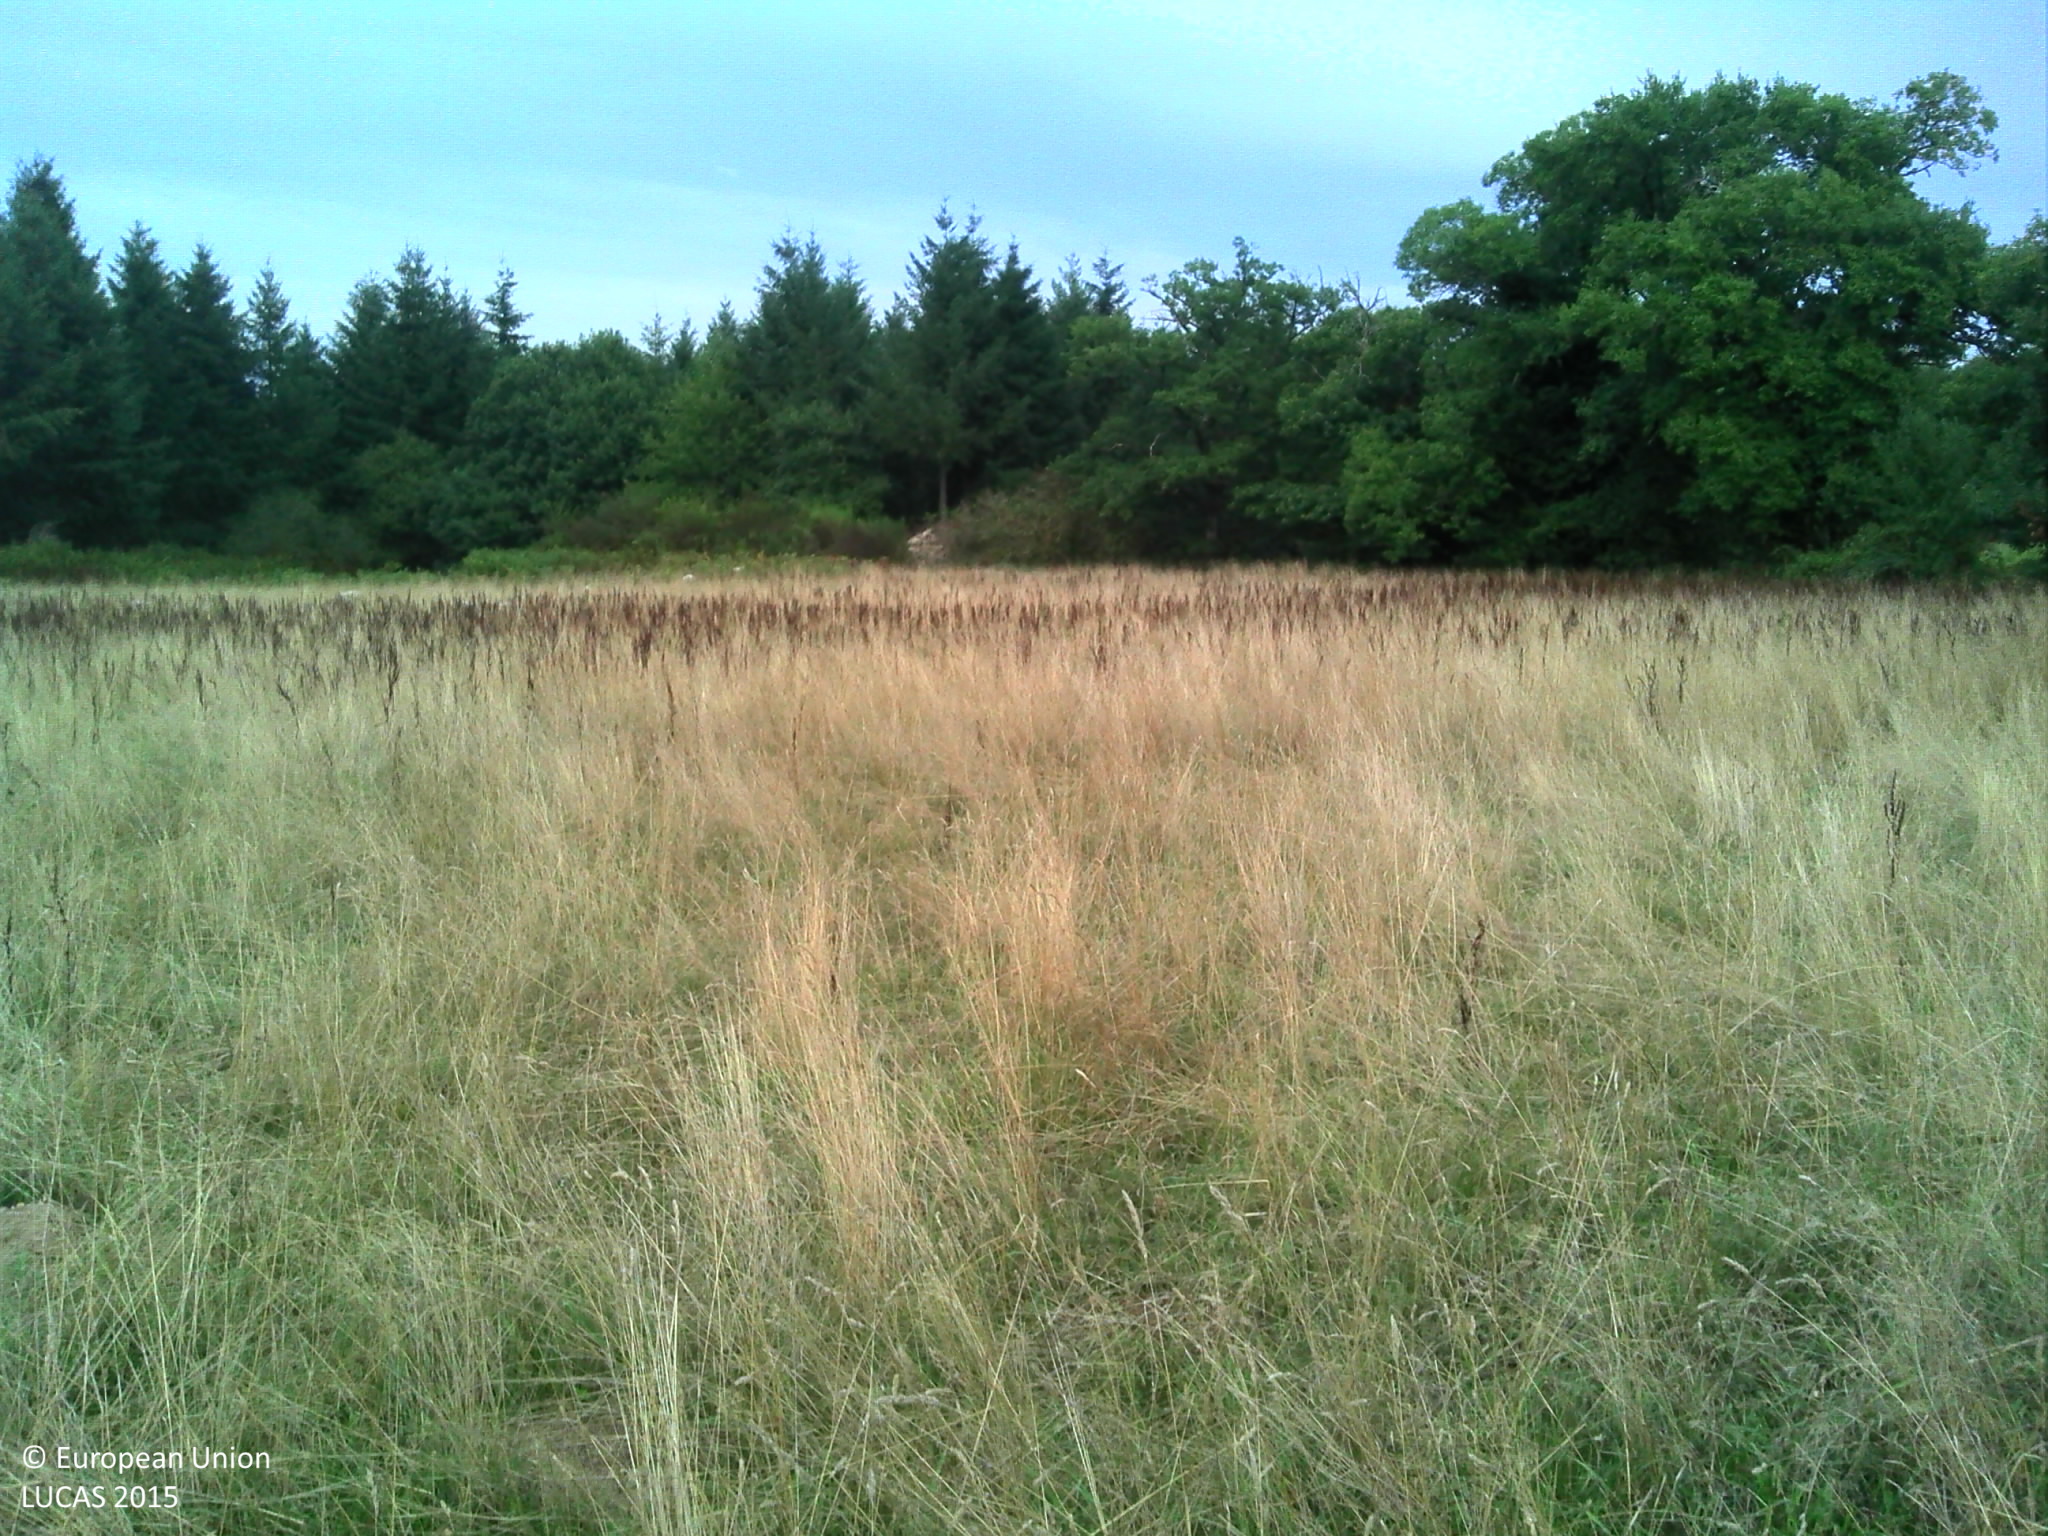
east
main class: Grassland
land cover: Grassland without tree/shrub cover
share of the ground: > 75 %
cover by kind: herbaceous plants 100 %
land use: Agriculture (excluding fallow land and kitchen gardens)
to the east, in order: Grassland without tree/shrub cover; Spontaneously vegetated surfaces; Fences; Spruce dominated coniferous woodland; Broadleaved woodland; Dry stone walls; Fences; Grassland without tree/shrub cover
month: August
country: FR
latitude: 46.1214
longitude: 1.2806
